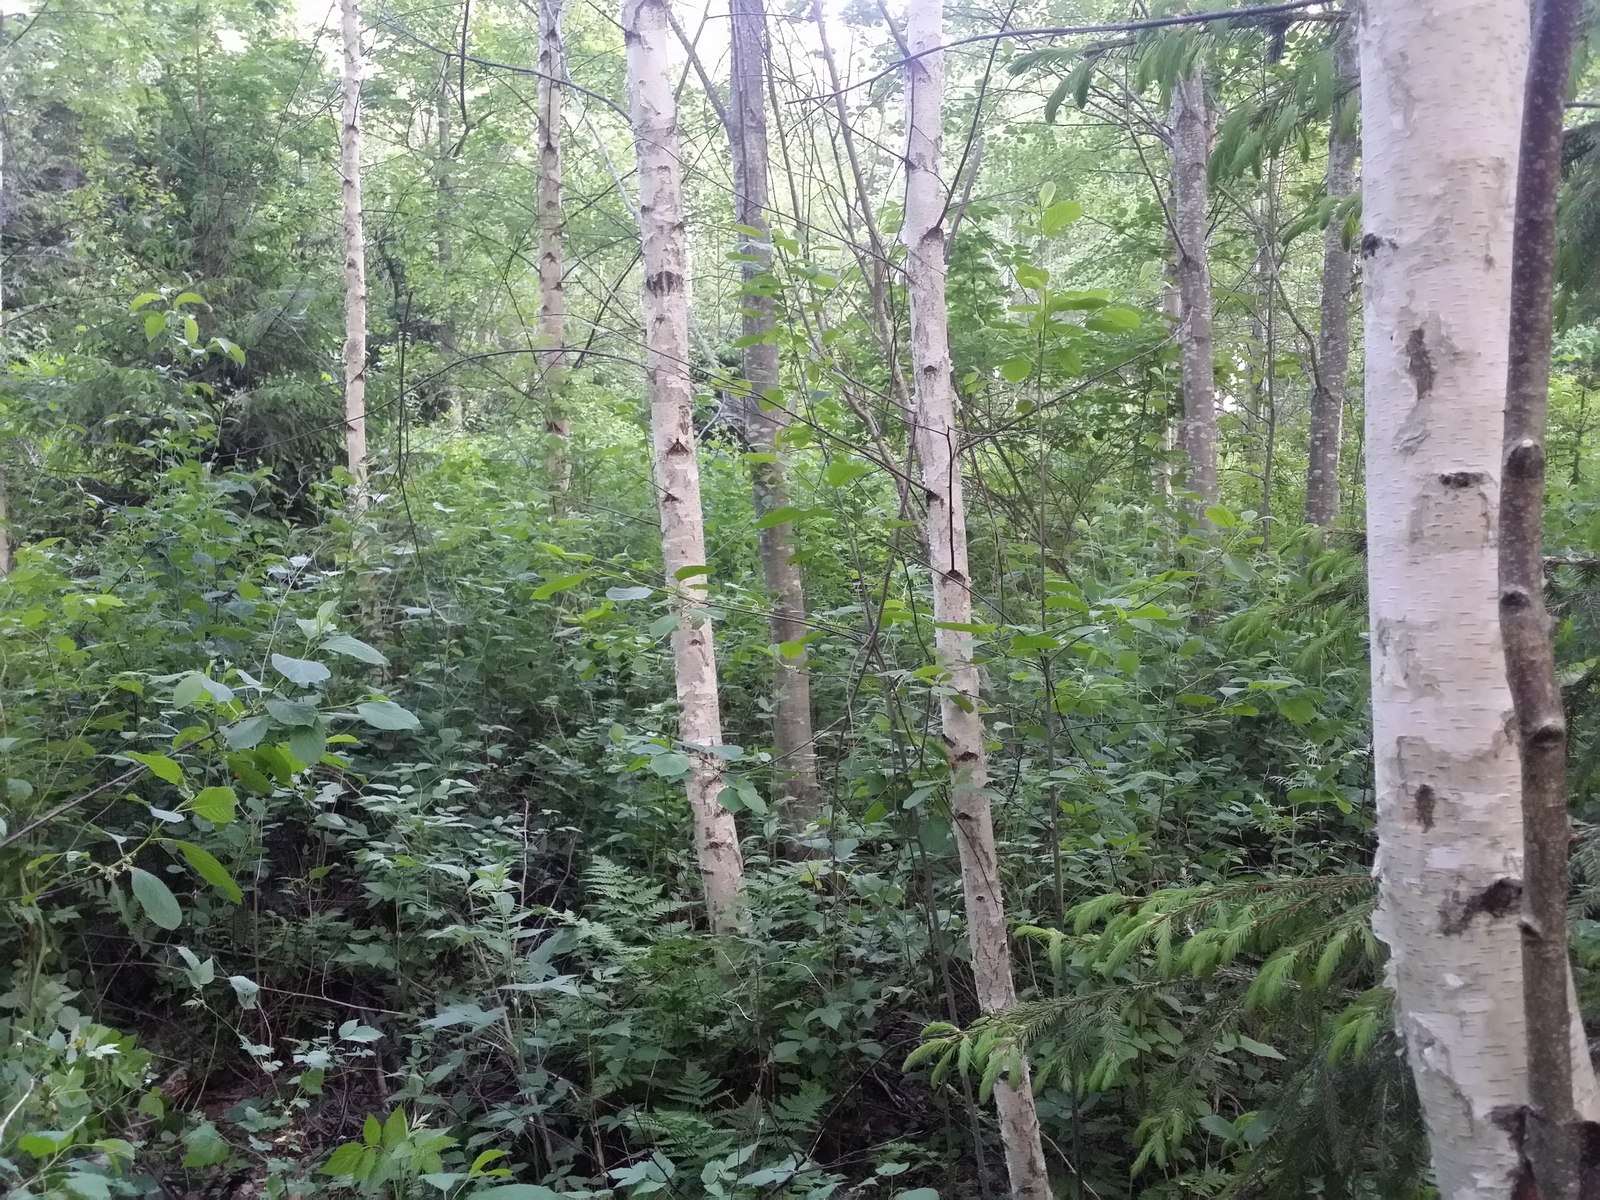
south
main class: Woodland
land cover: Spruce dominated mixed woodland
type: hemiboreal forest and nemoral coniferous forest and mixed broadleaved-coniferous forest
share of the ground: > 75 %
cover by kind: broadleaved forest trees 60 %, coniferous forest trees 20 %, shrubs 10 %, herbaceous plants 10 %
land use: Forestry
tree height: > 5 m
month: June
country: LV
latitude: 57.3052
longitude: 26.5960
